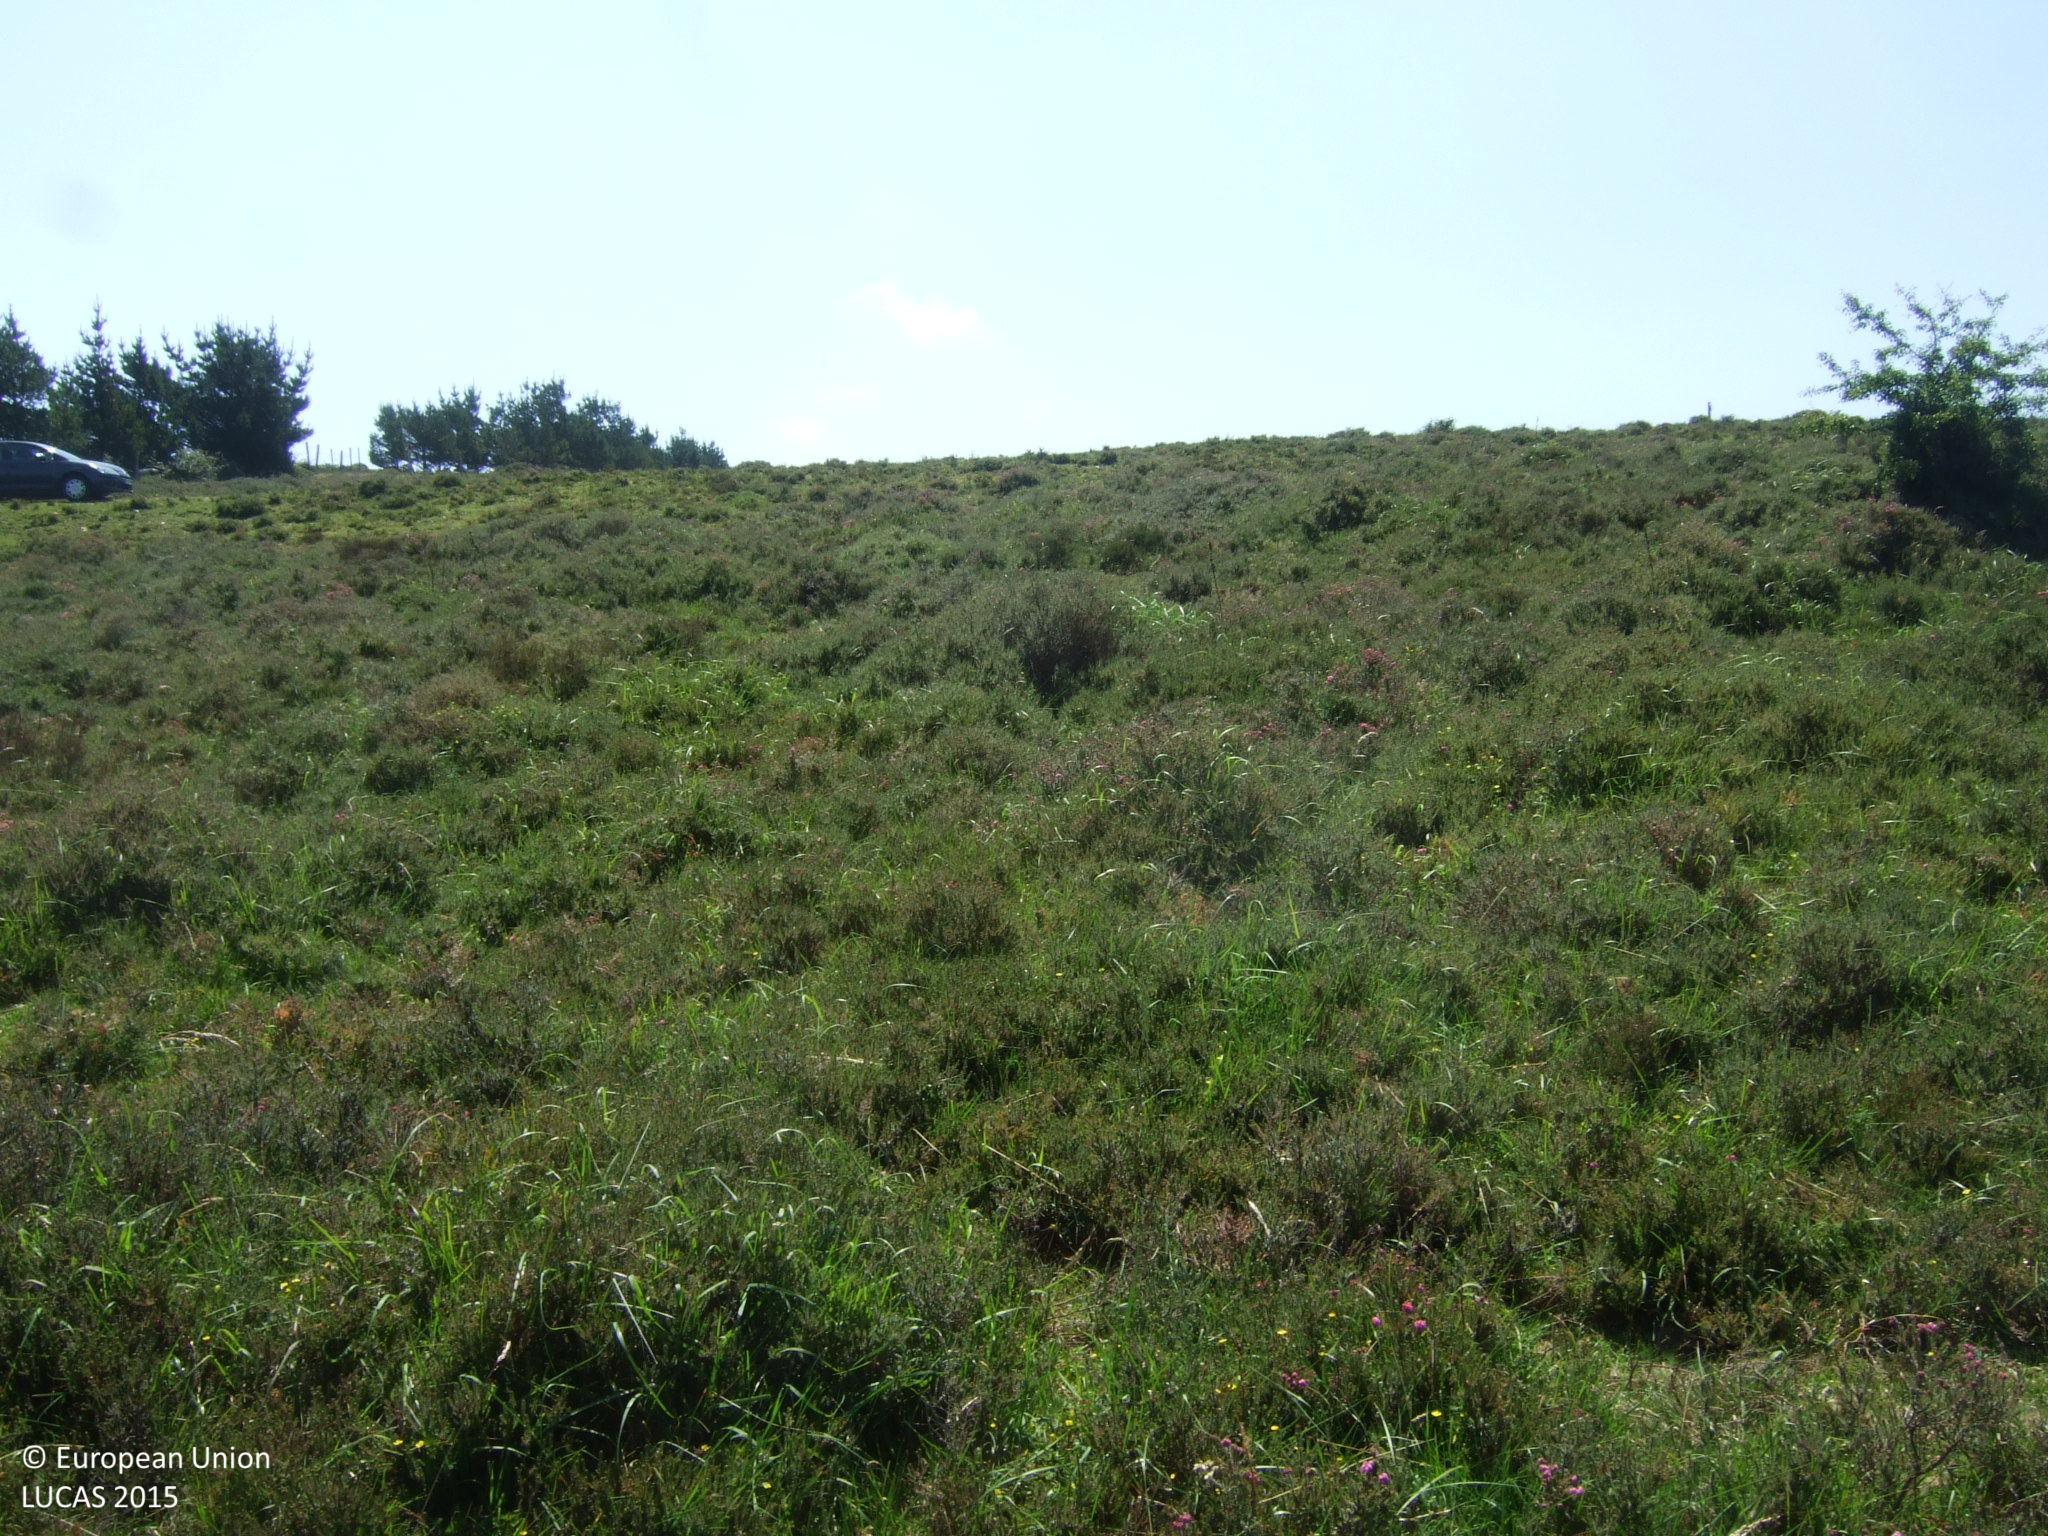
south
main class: Shrubland
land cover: Shrubland without tree cover
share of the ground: > 75 %
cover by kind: shrubs 90 %, herbaceous plants 10 %
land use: Agriculture (excluding fallow land and kitchen gardens)
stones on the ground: 10 - 25 %
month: June
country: ES
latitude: 43.5589
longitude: -7.5512
